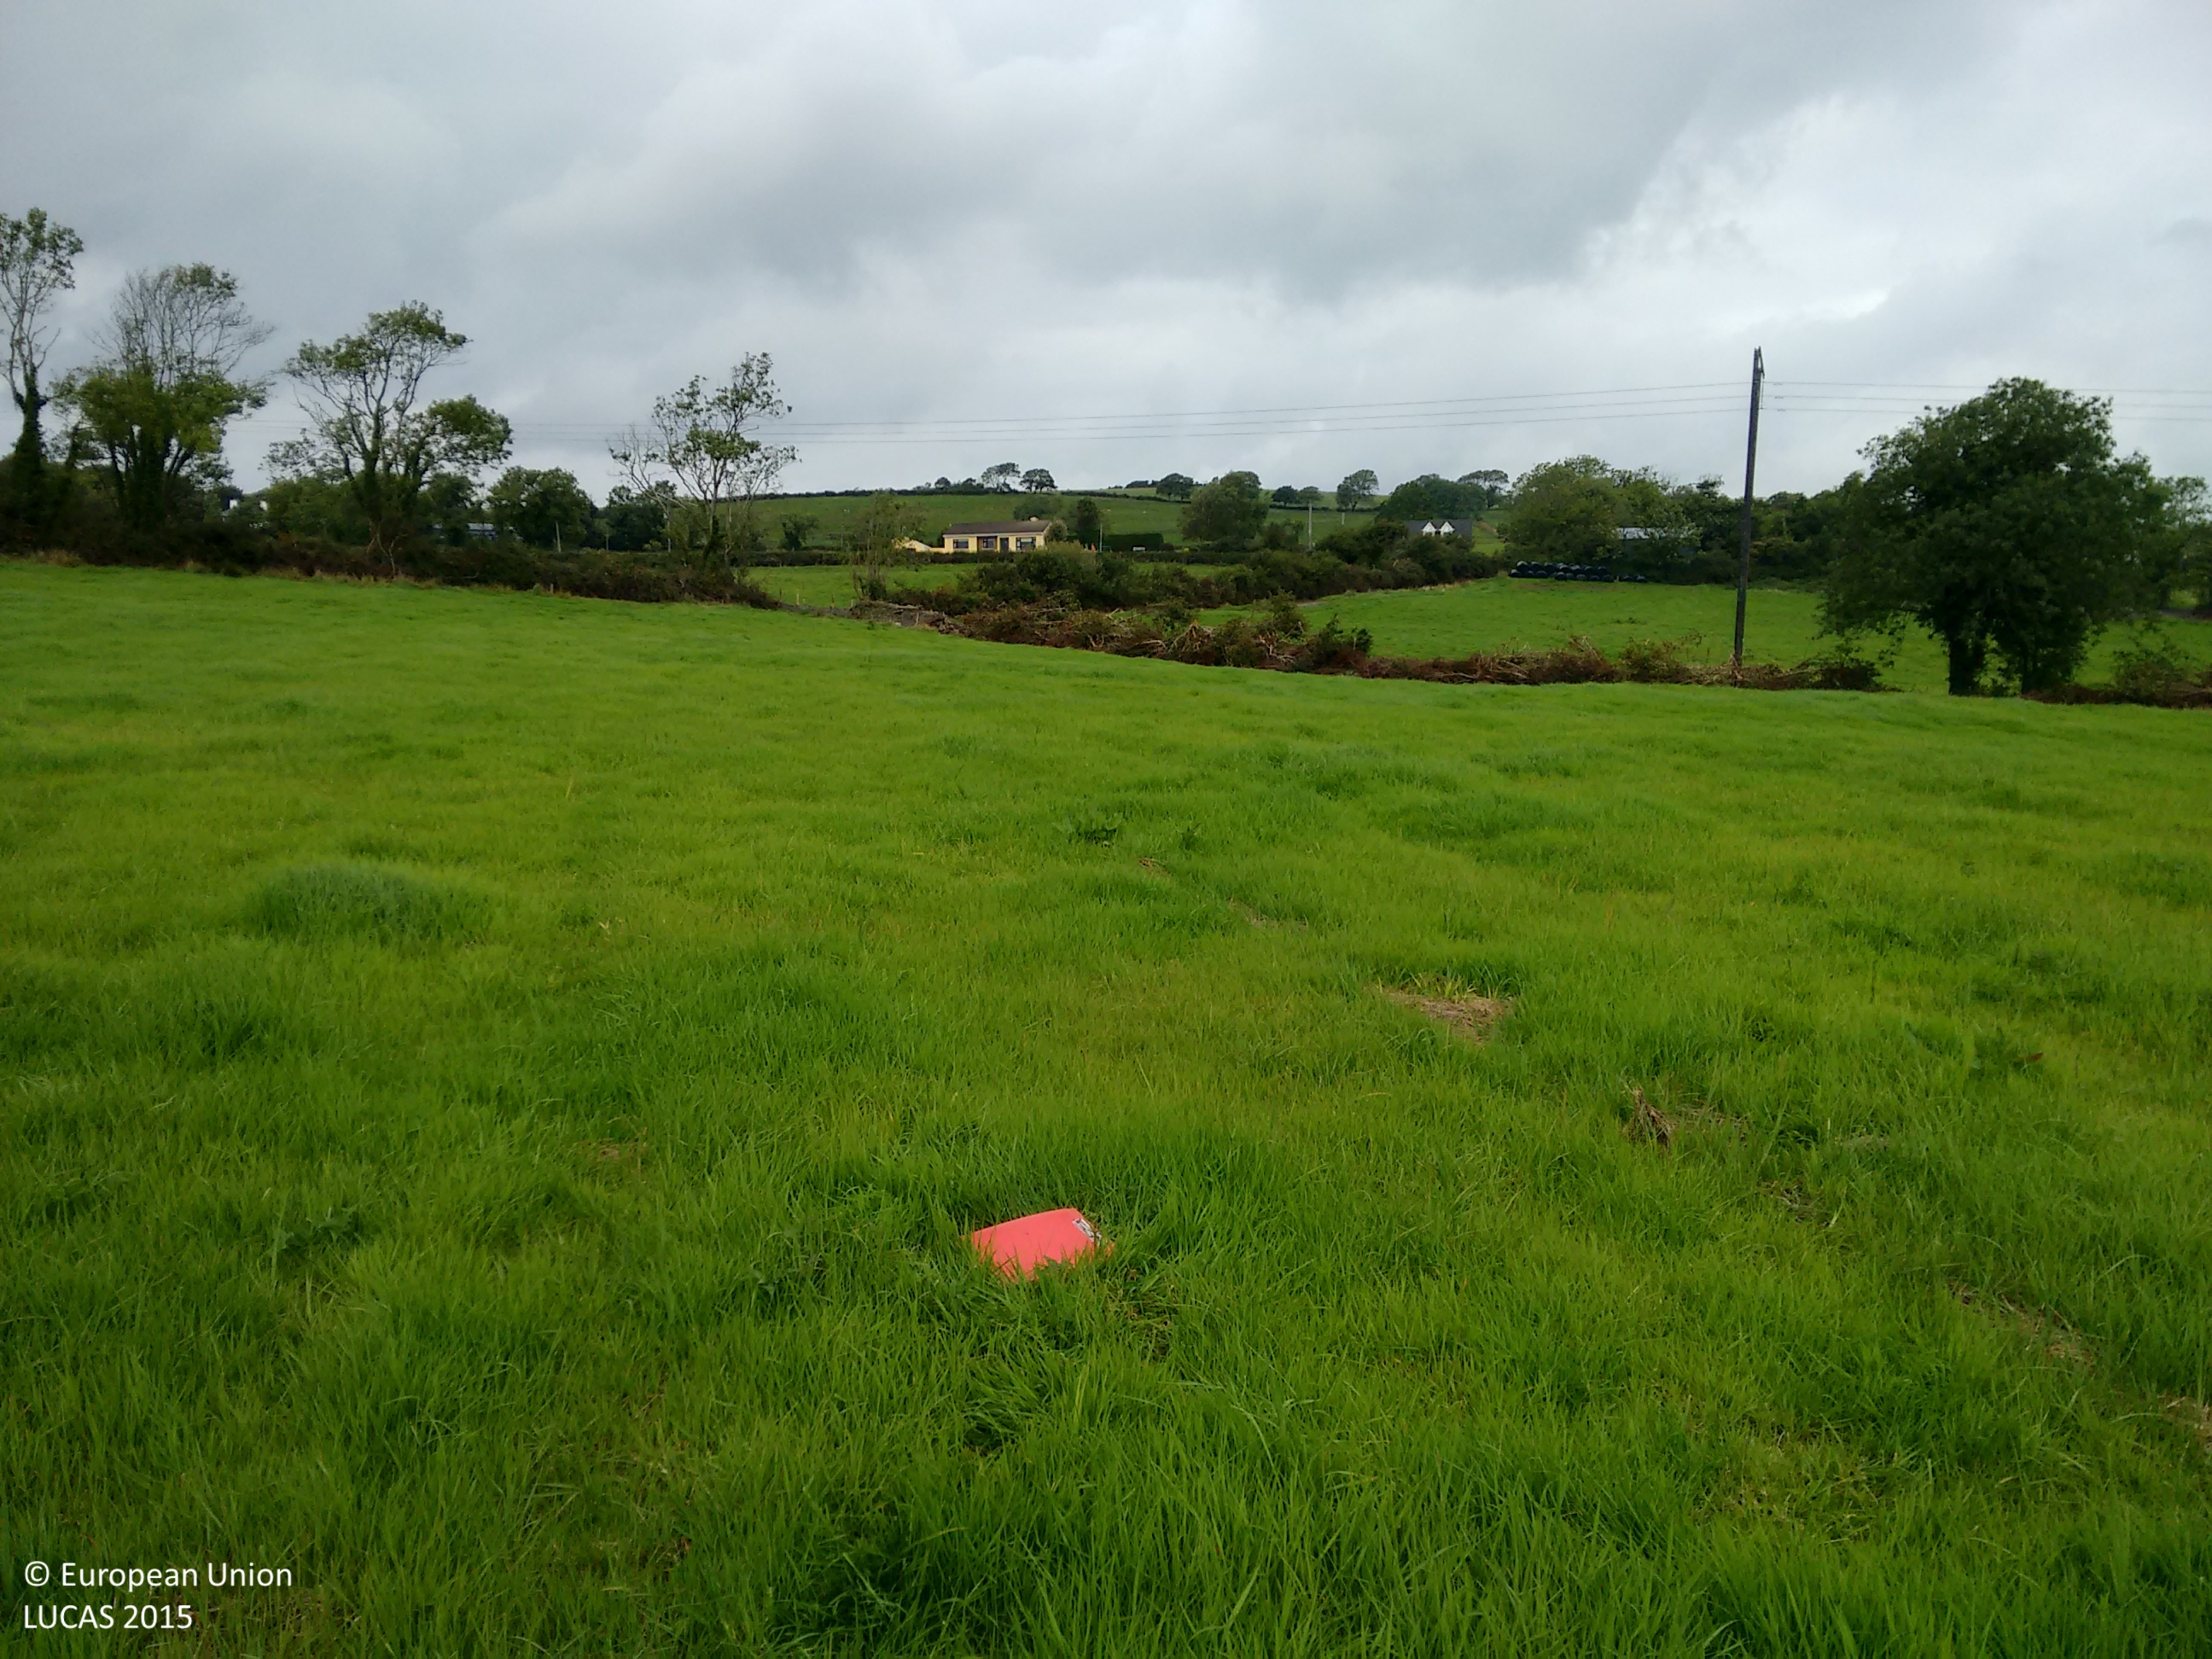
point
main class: Grassland
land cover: Grassland without tree/shrub cover
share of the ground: > 75 %
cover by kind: herbaceous plants 100 %
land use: Agriculture (excluding fallow land and kitchen gardens)
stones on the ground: < 10 %
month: September
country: IE
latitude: 52.5609
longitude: -9.1138
